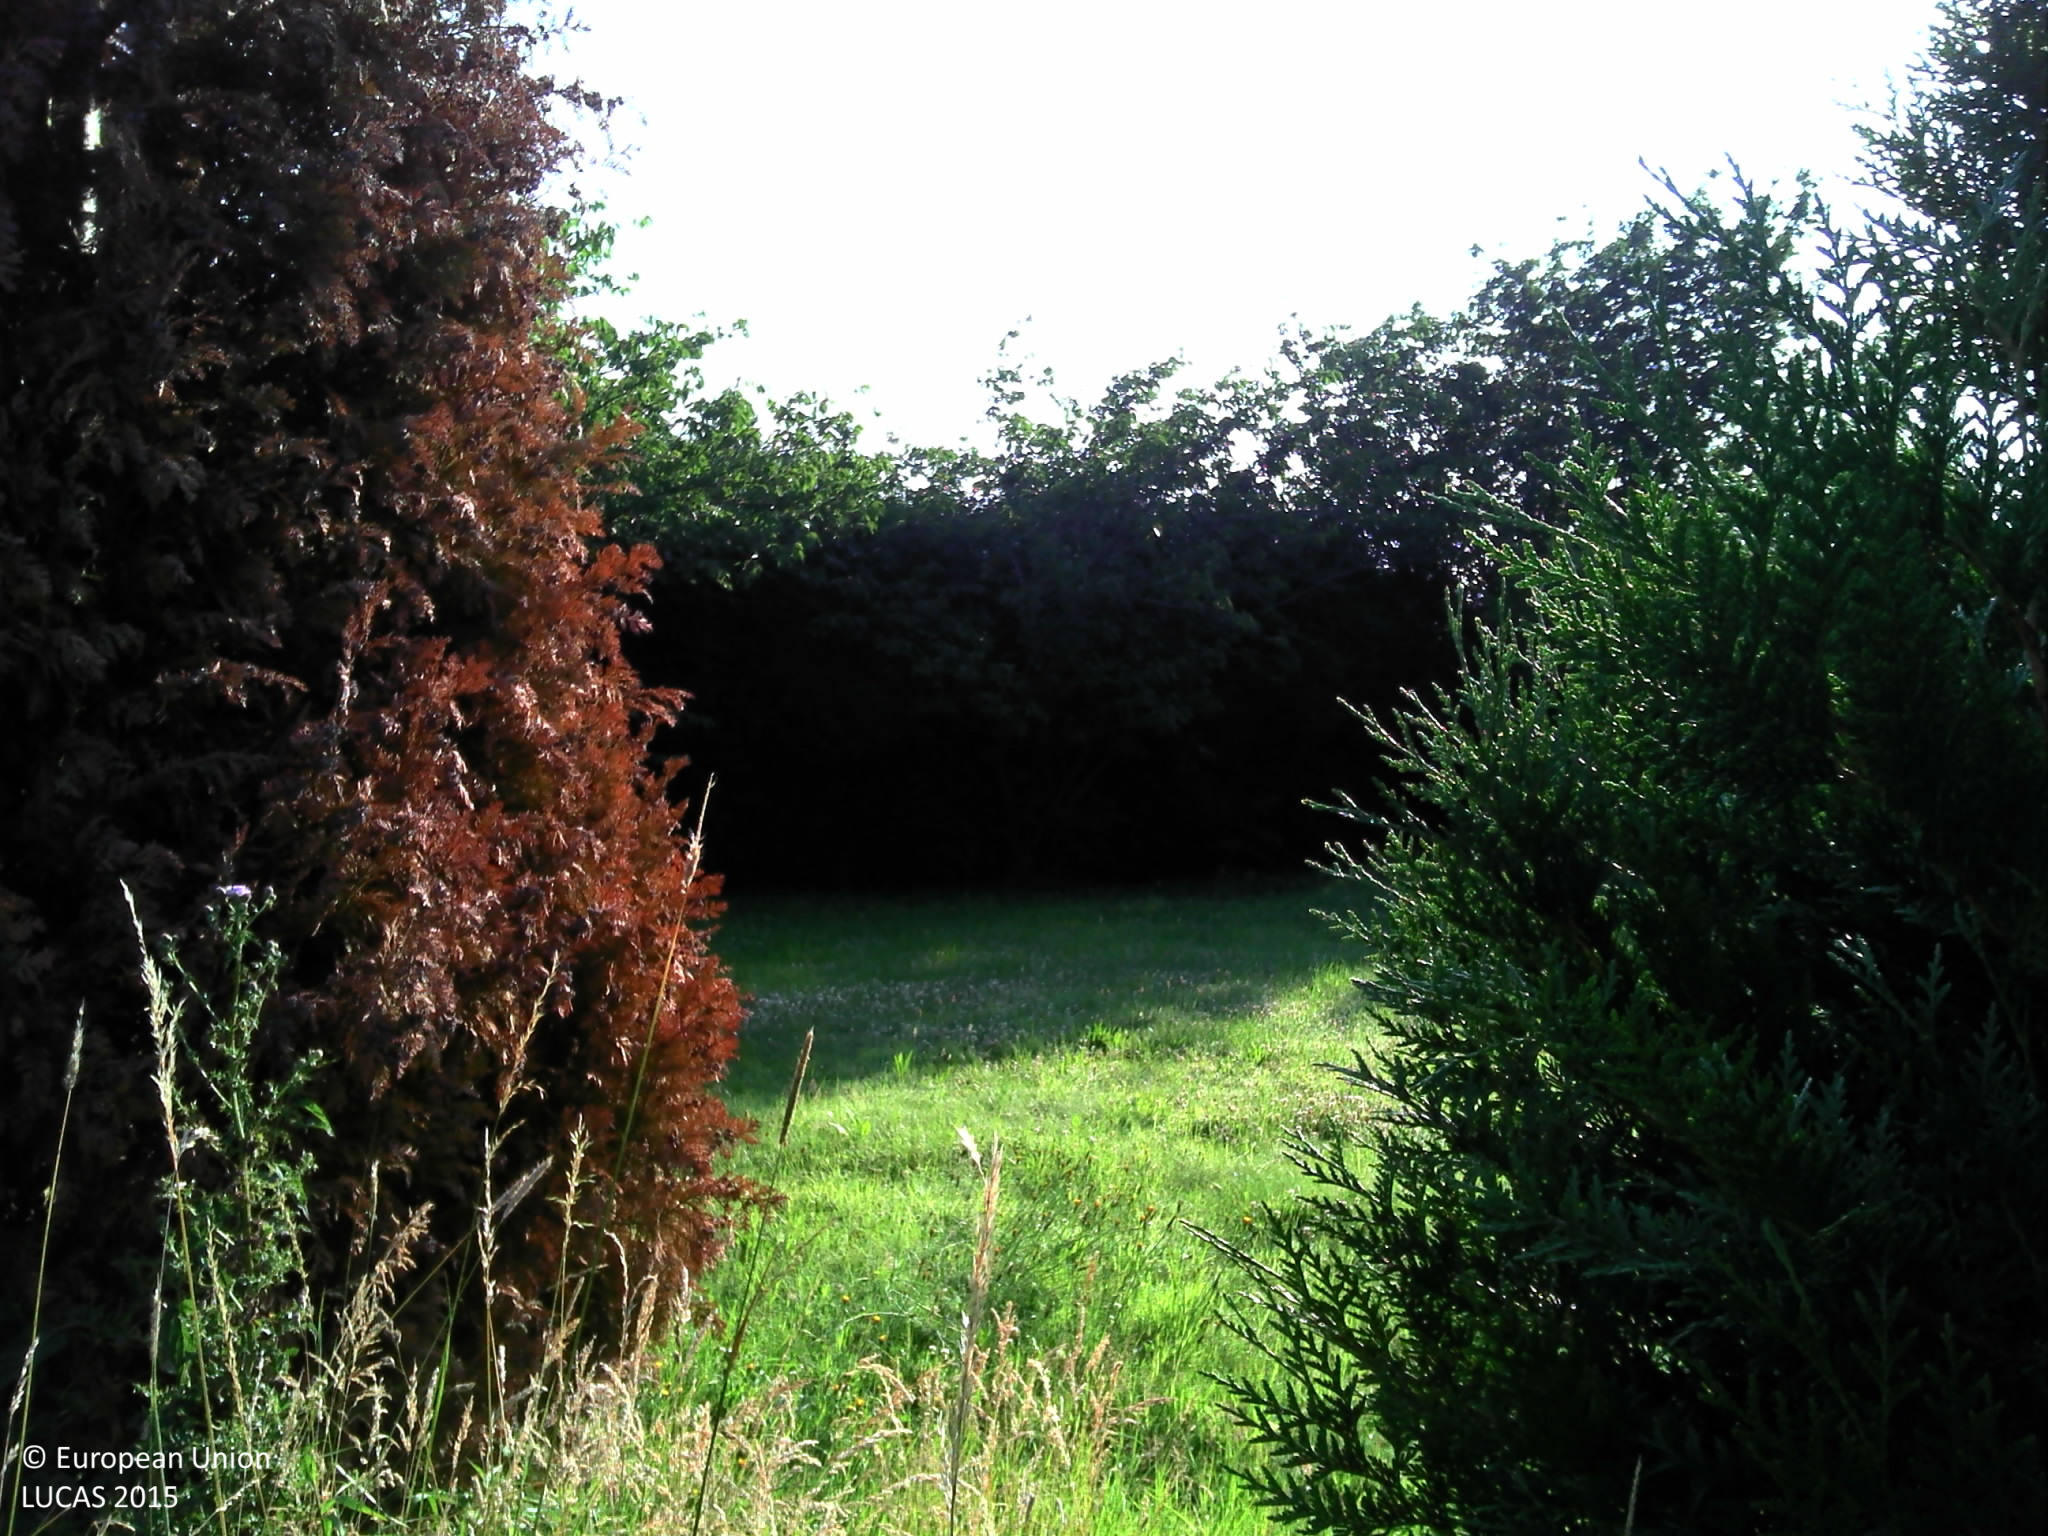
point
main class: Grassland
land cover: Grassland with sparse tree/shrub cover
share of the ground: > 75 %
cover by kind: herbaceous plants 95 %, broadleaved forest trees 5 %
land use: Residential
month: July
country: BE
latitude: 50.3365
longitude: 4.8124
